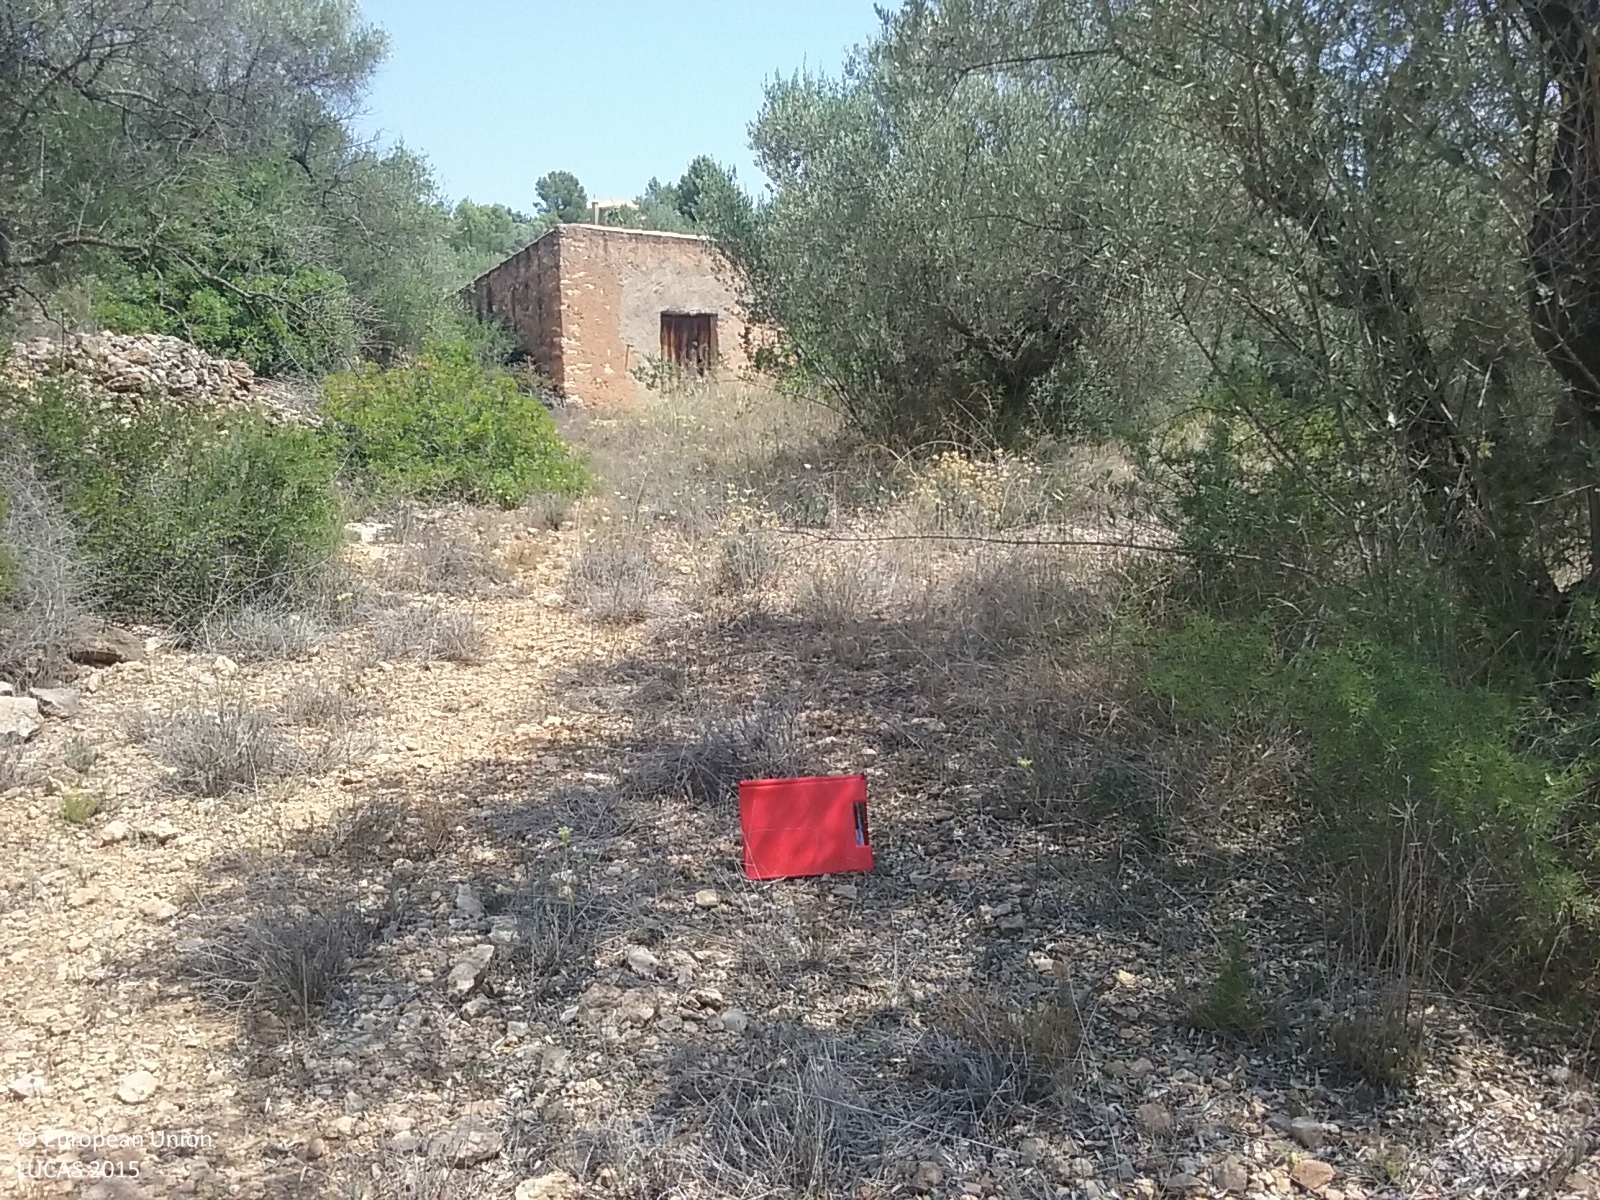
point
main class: Cropland
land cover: Olive groves
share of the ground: 25 - 50 %
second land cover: Grassland without tree/shrub cover
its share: 50 - 75 %
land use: Abandoned areas
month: July
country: ES
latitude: 40.1495
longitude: -0.0629
